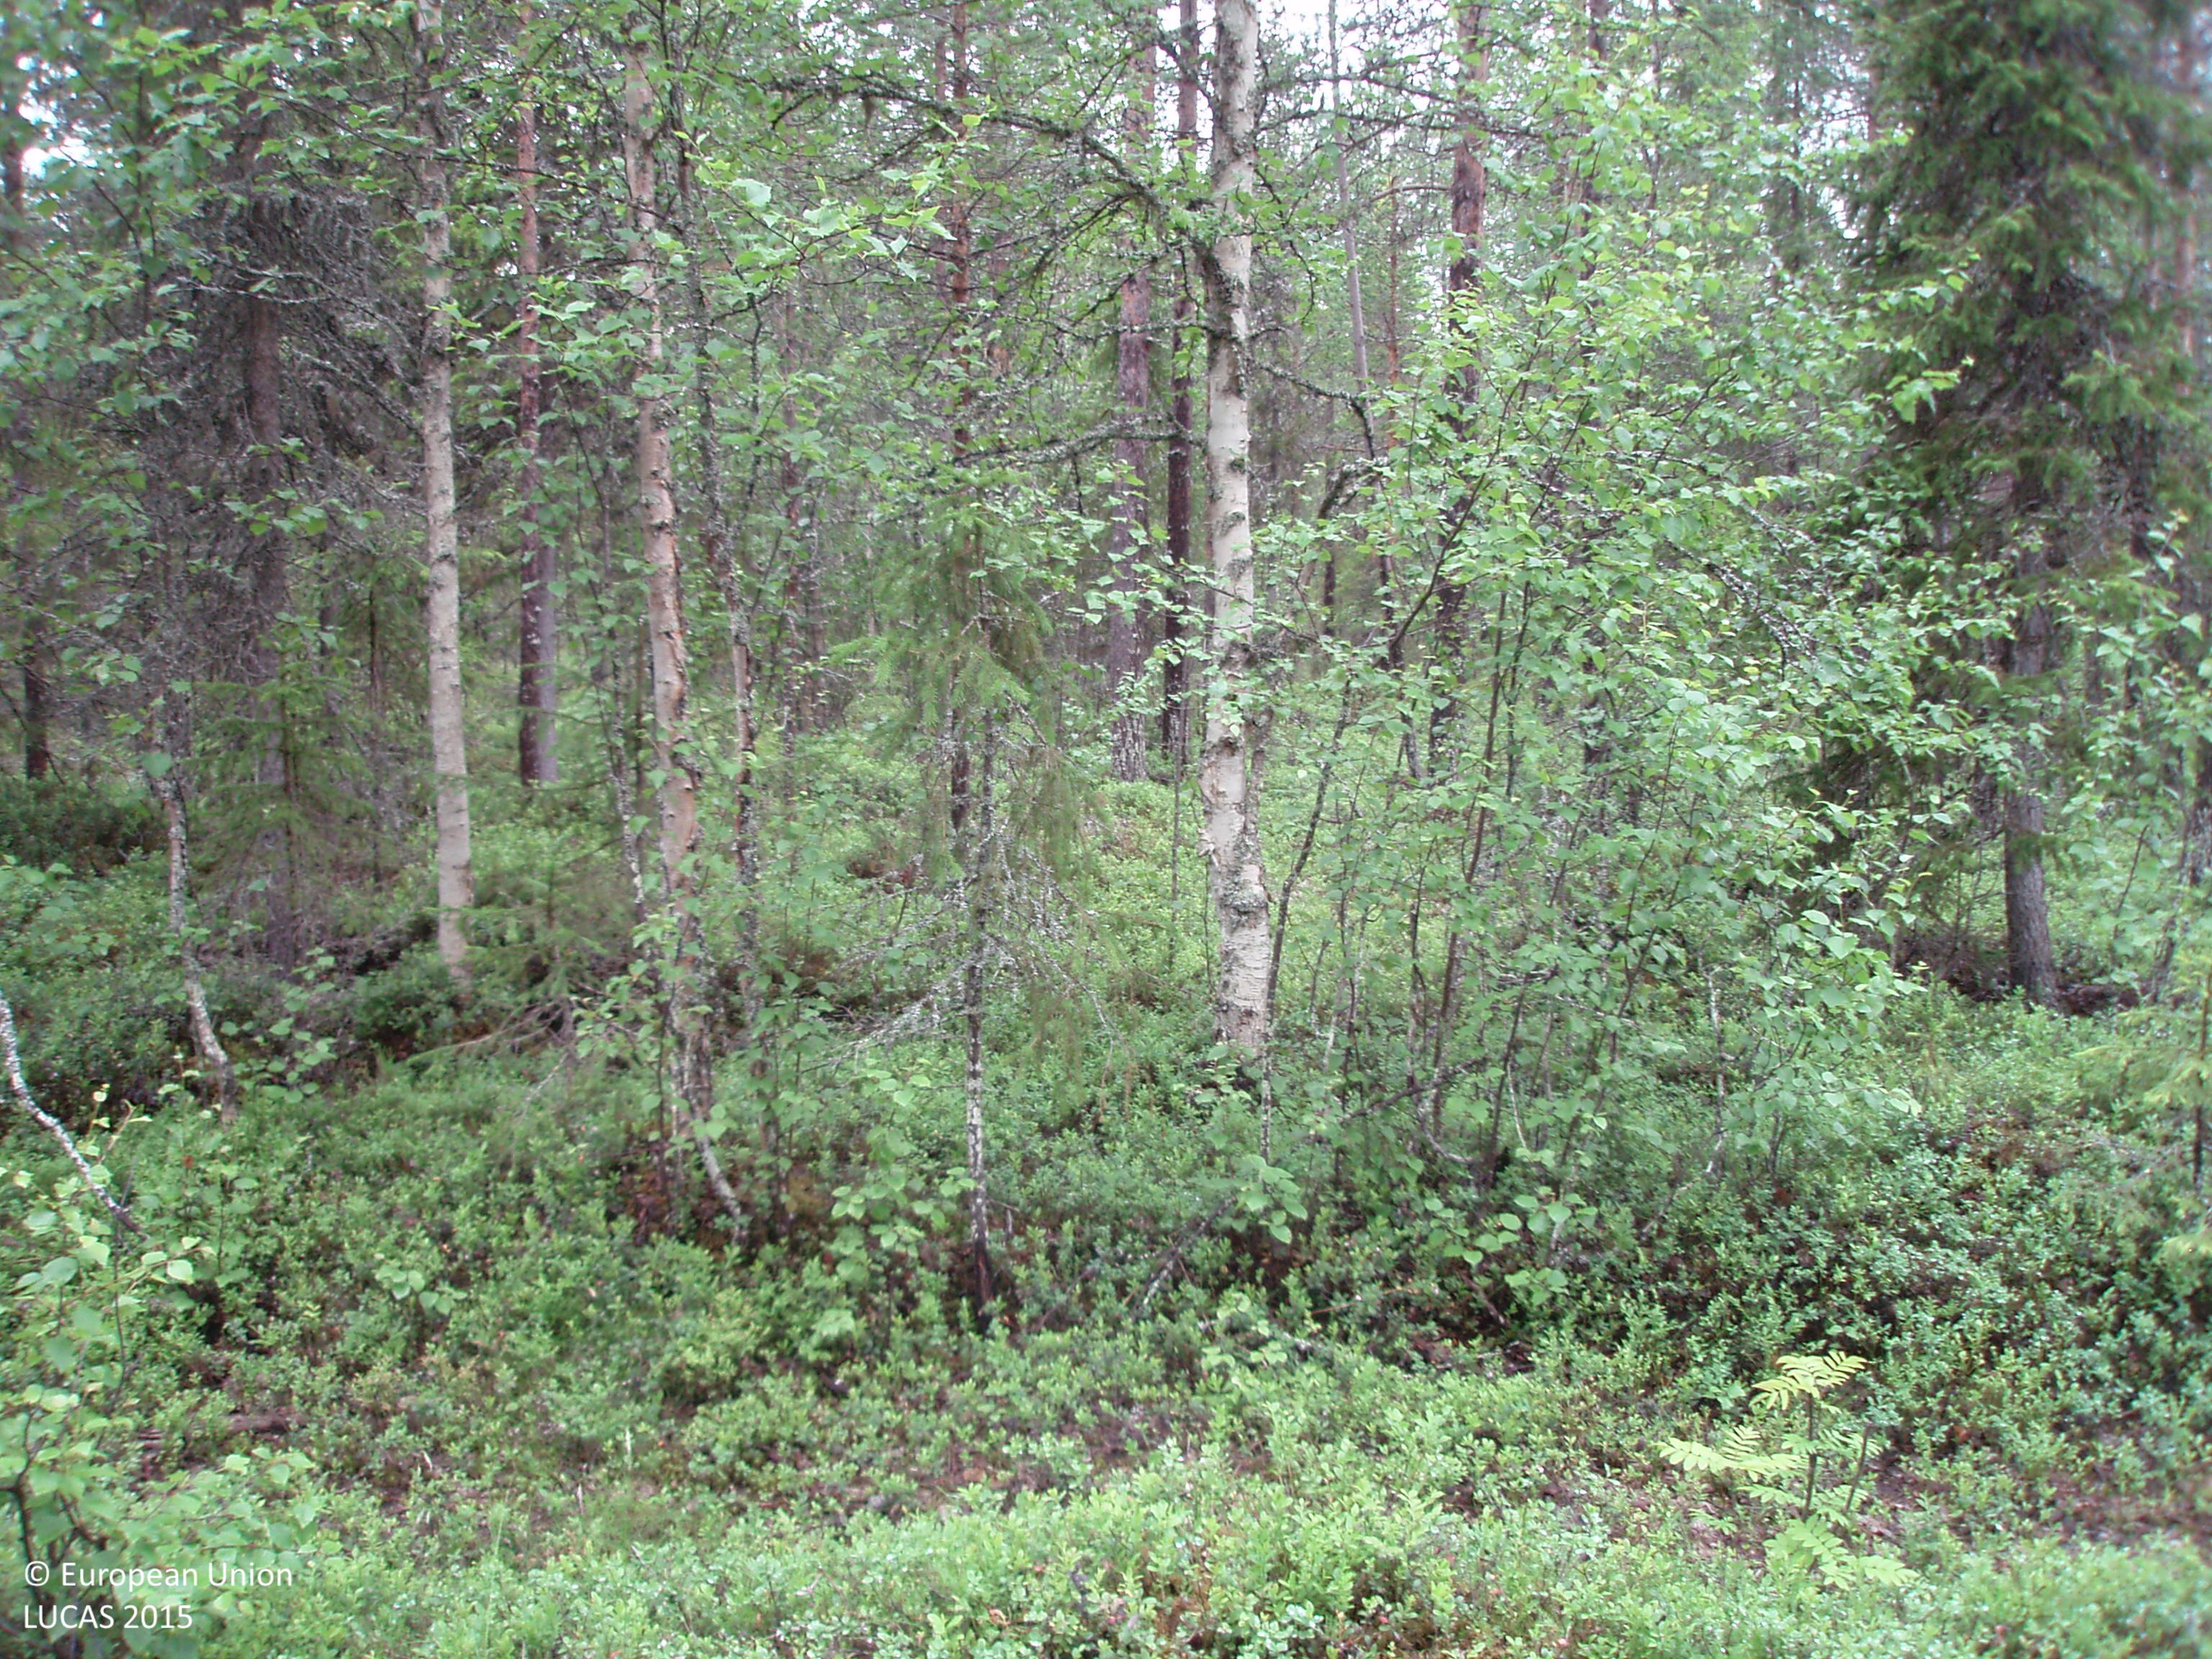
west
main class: Woodland
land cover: Pine dominated mixed woodland
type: boreal forest
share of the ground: > 75 %
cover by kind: coniferous forest trees 60 %, broadleaved forest trees 25 %, shrubs 15 %
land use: Forestry
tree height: > 5 m
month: July
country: FI
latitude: 67.0908
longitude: 28.8638
